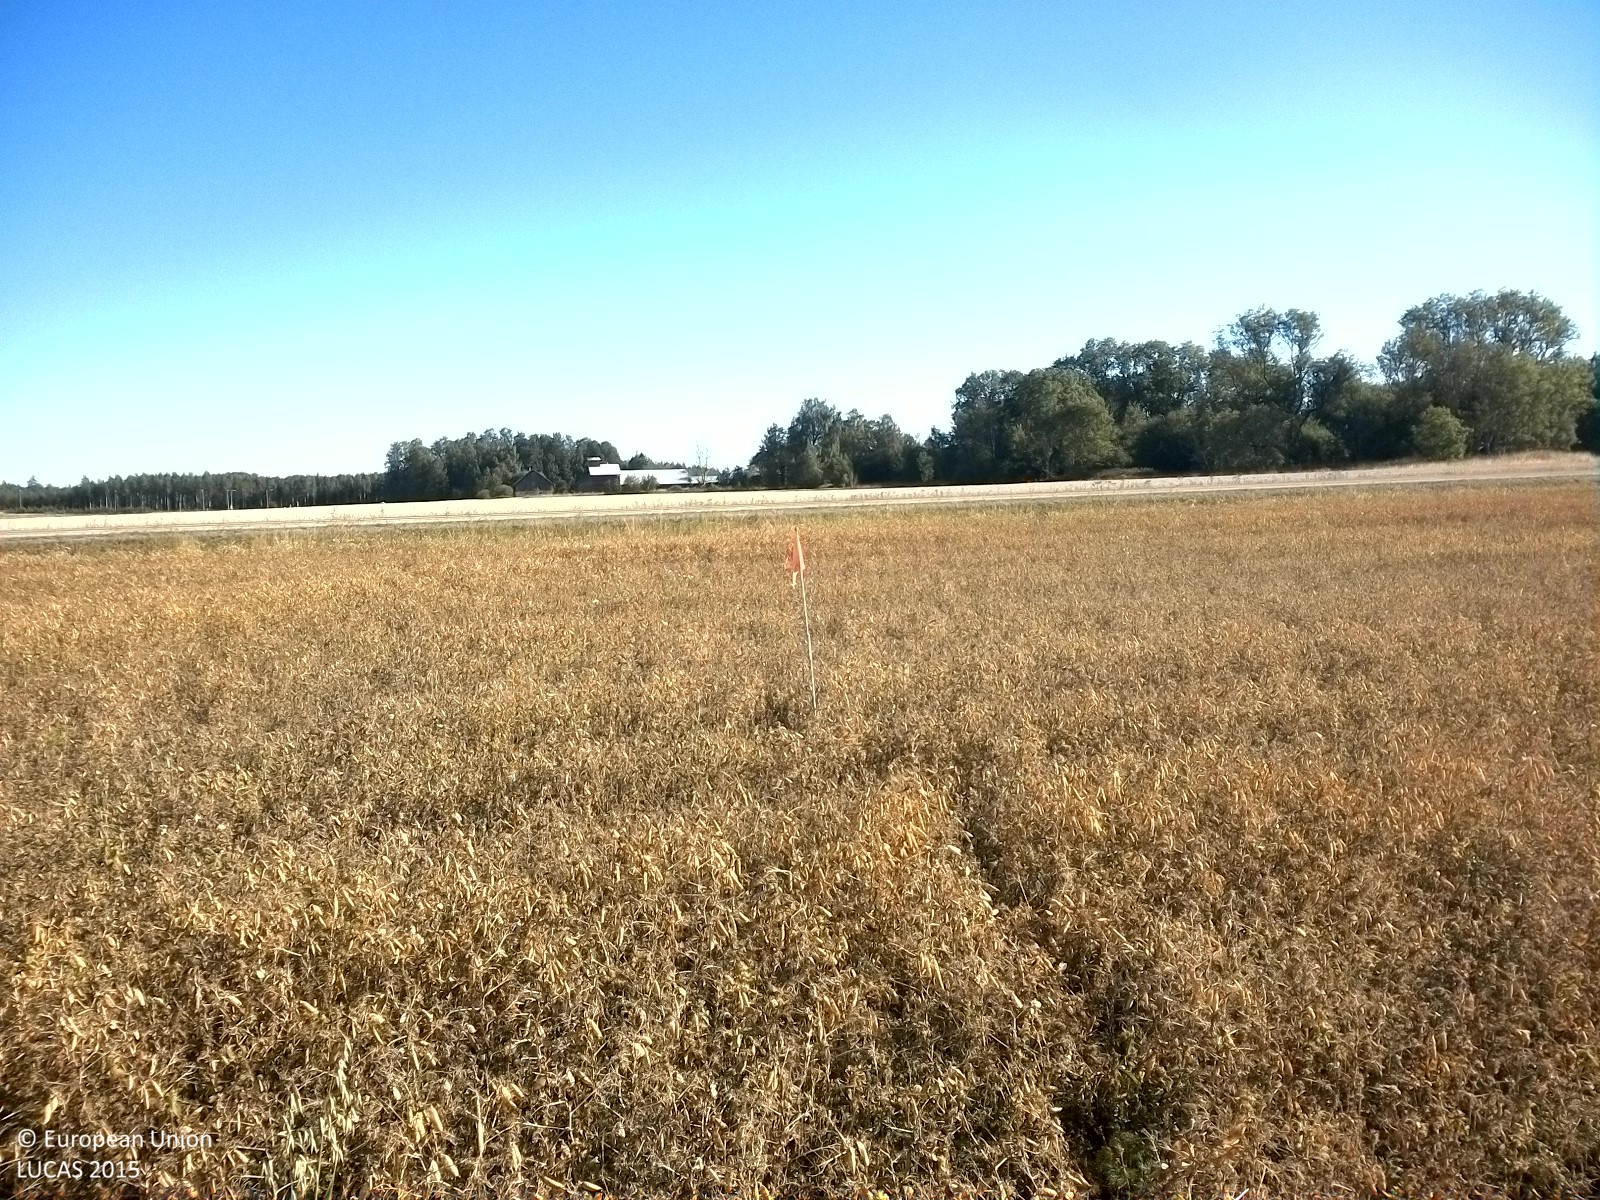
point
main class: Cropland
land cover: Dry pulses
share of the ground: > 75 %
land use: Agriculture (excluding fallow land and kitchen gardens)
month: August
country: SE
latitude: 59.2422
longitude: 15.0580
